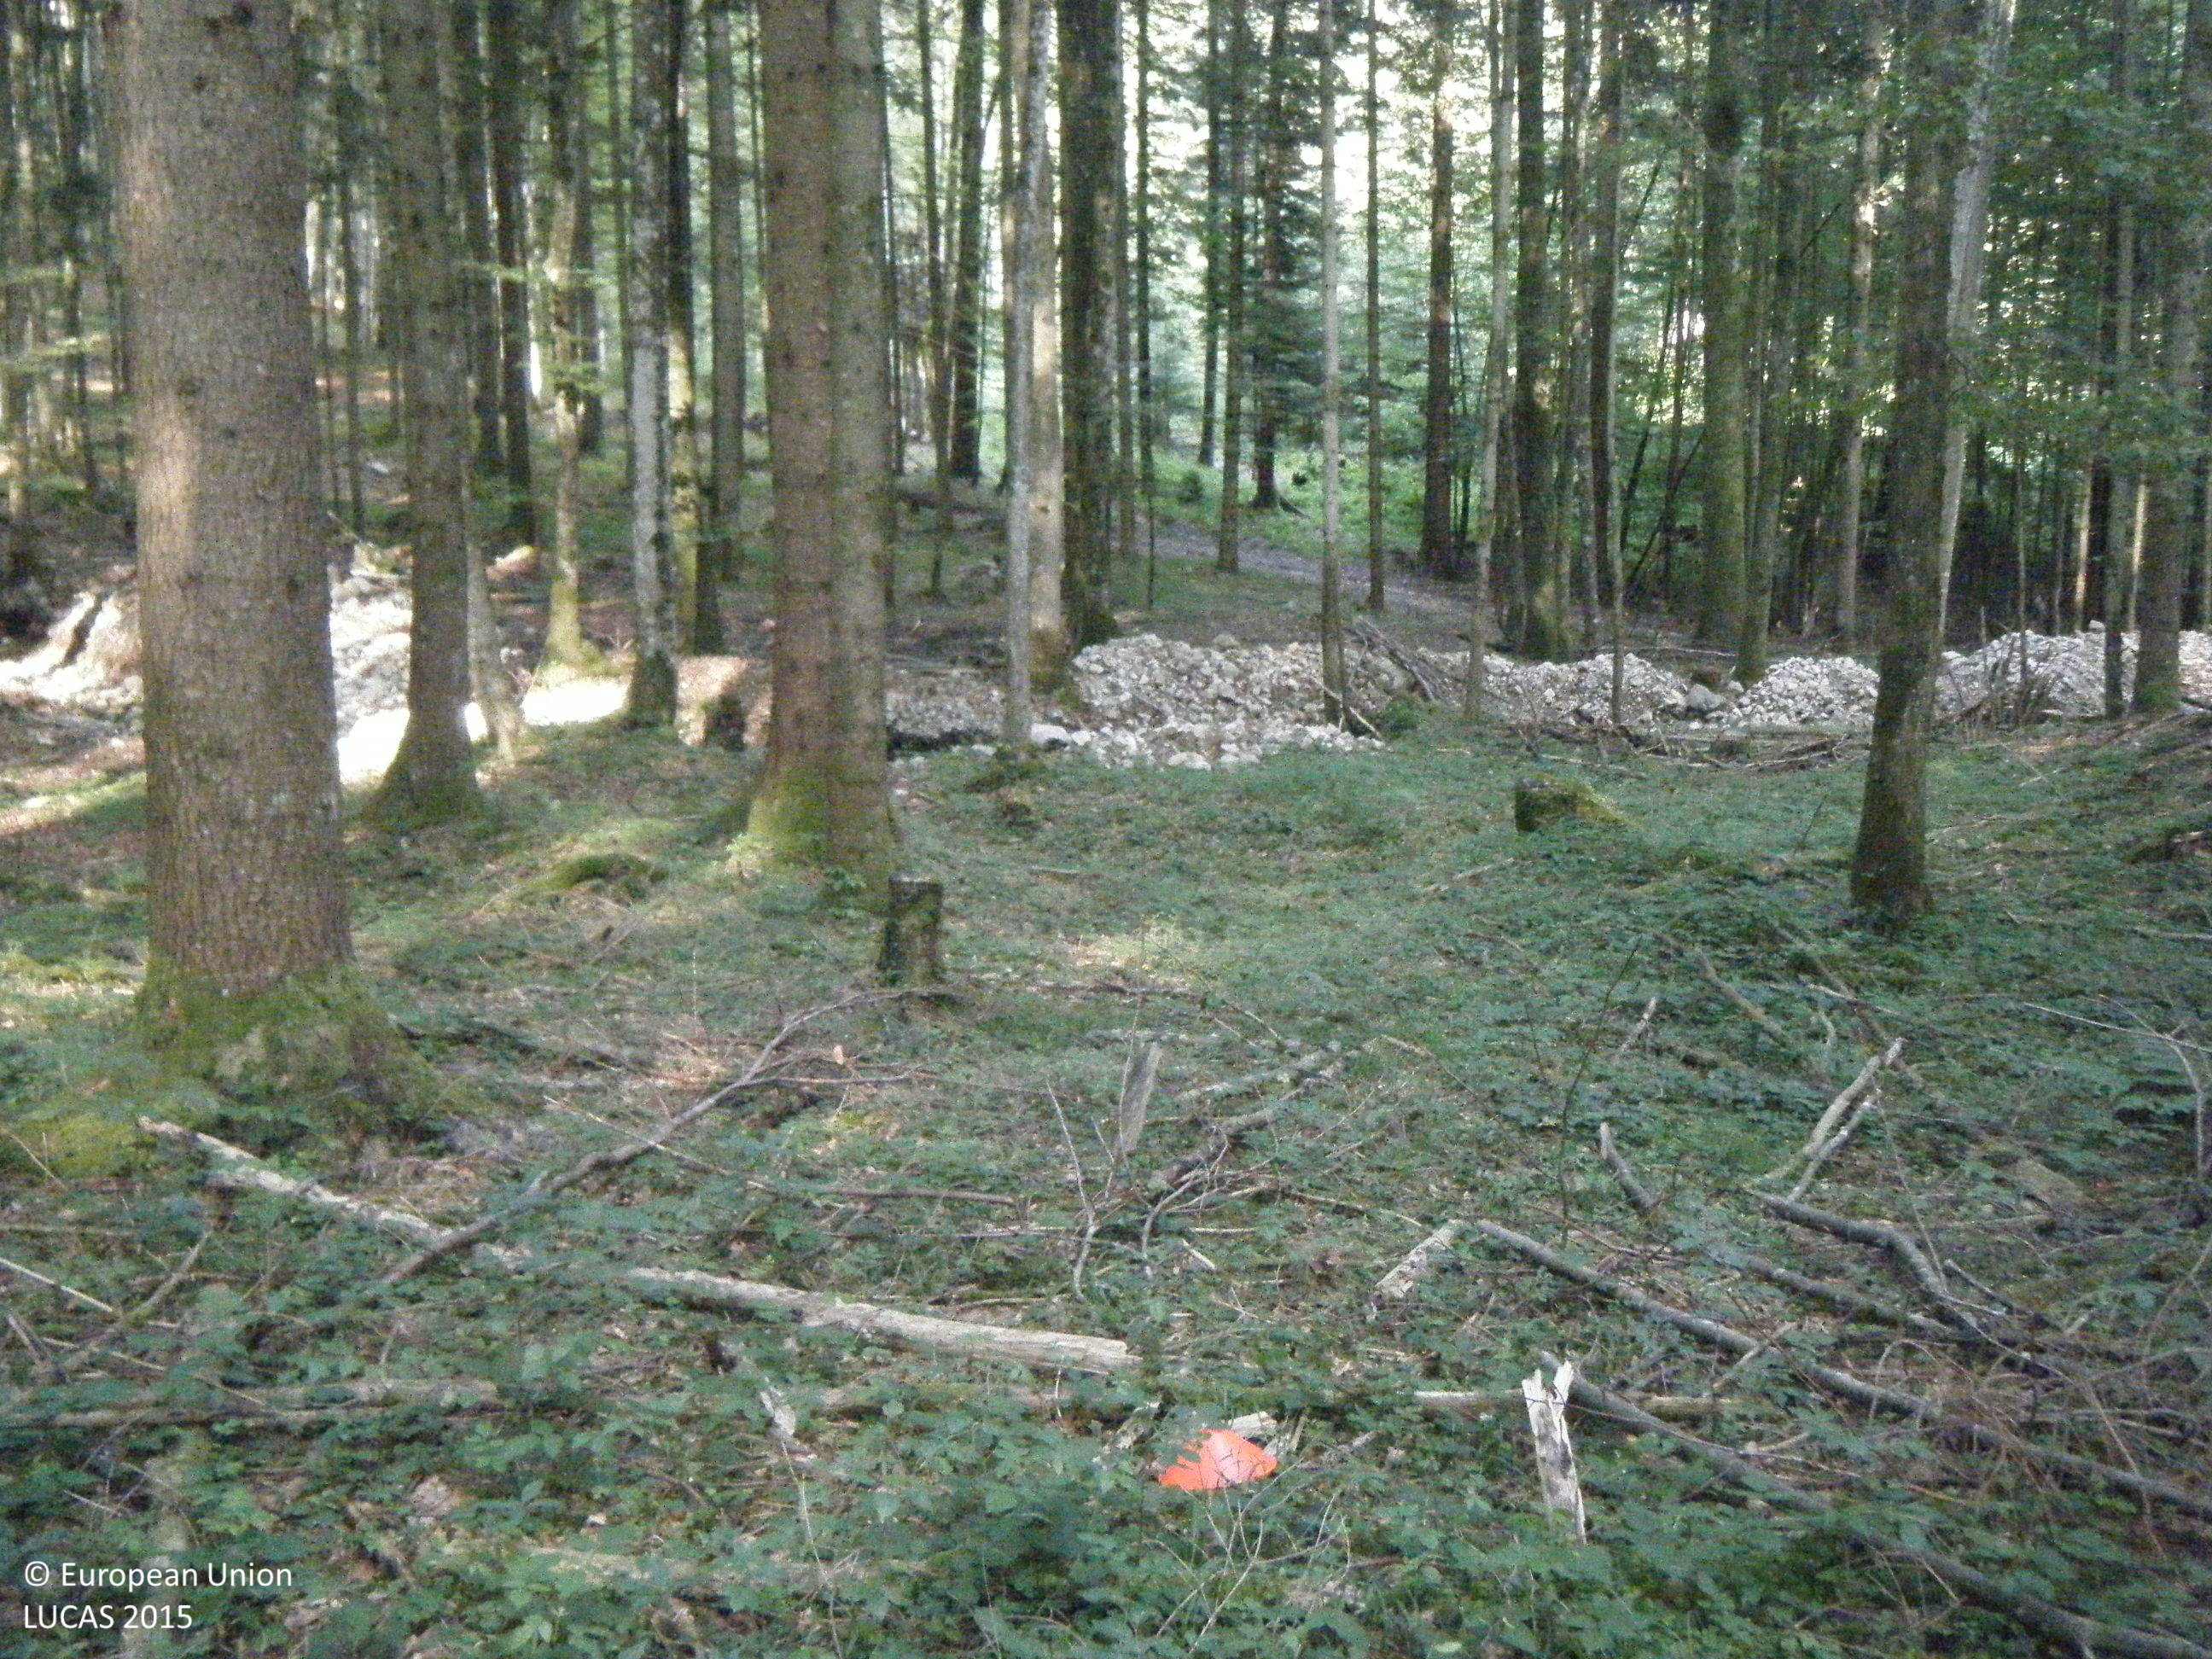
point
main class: Woodland
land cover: Spruce dominated mixed woodland
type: alpine coniferous forest
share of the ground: > 75 %
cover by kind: coniferous forest trees 55 %, broadleaved forest trees 25 %, herbaceous plants 15 %, lichens and mosses 5 %
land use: Forestry
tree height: > 5 m
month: July
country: AT
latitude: 47.7364
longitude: 13.4791
